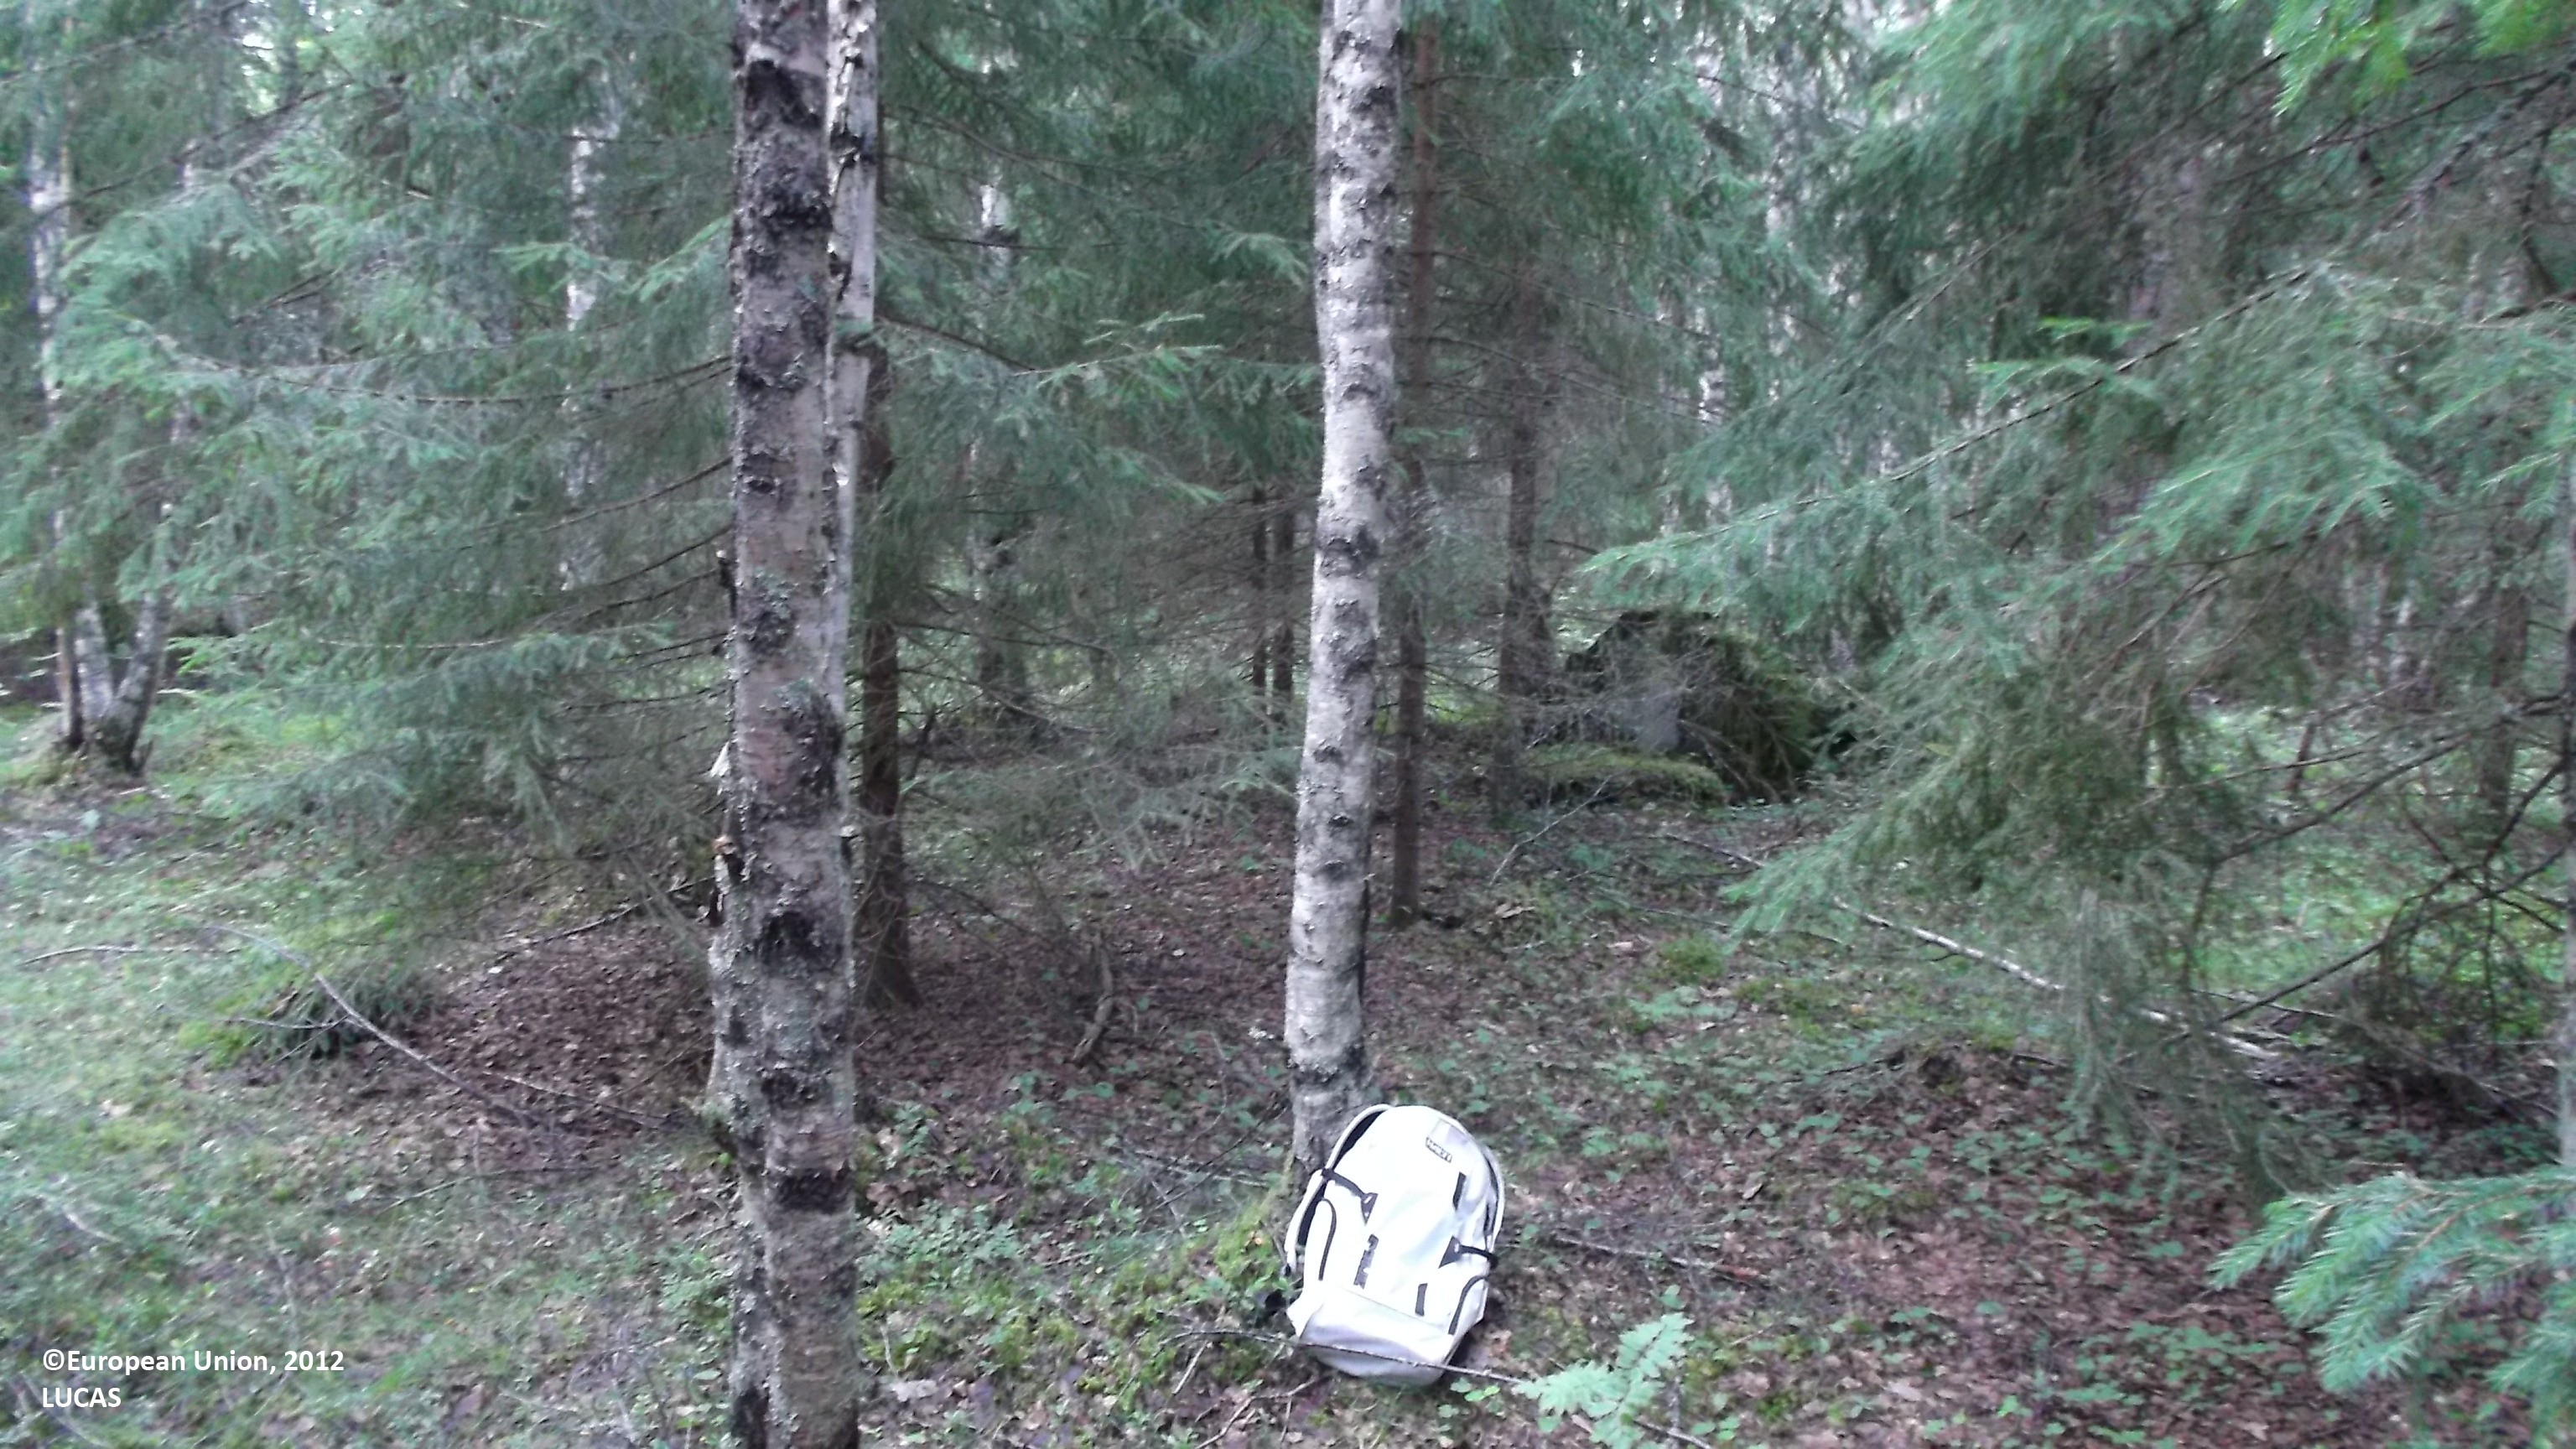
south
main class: Woodland
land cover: Other mixed woodland
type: boreal forest
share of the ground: > 75 %
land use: Forestry
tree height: > 5 m
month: July
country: FI
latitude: 63.3611
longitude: 23.8835
